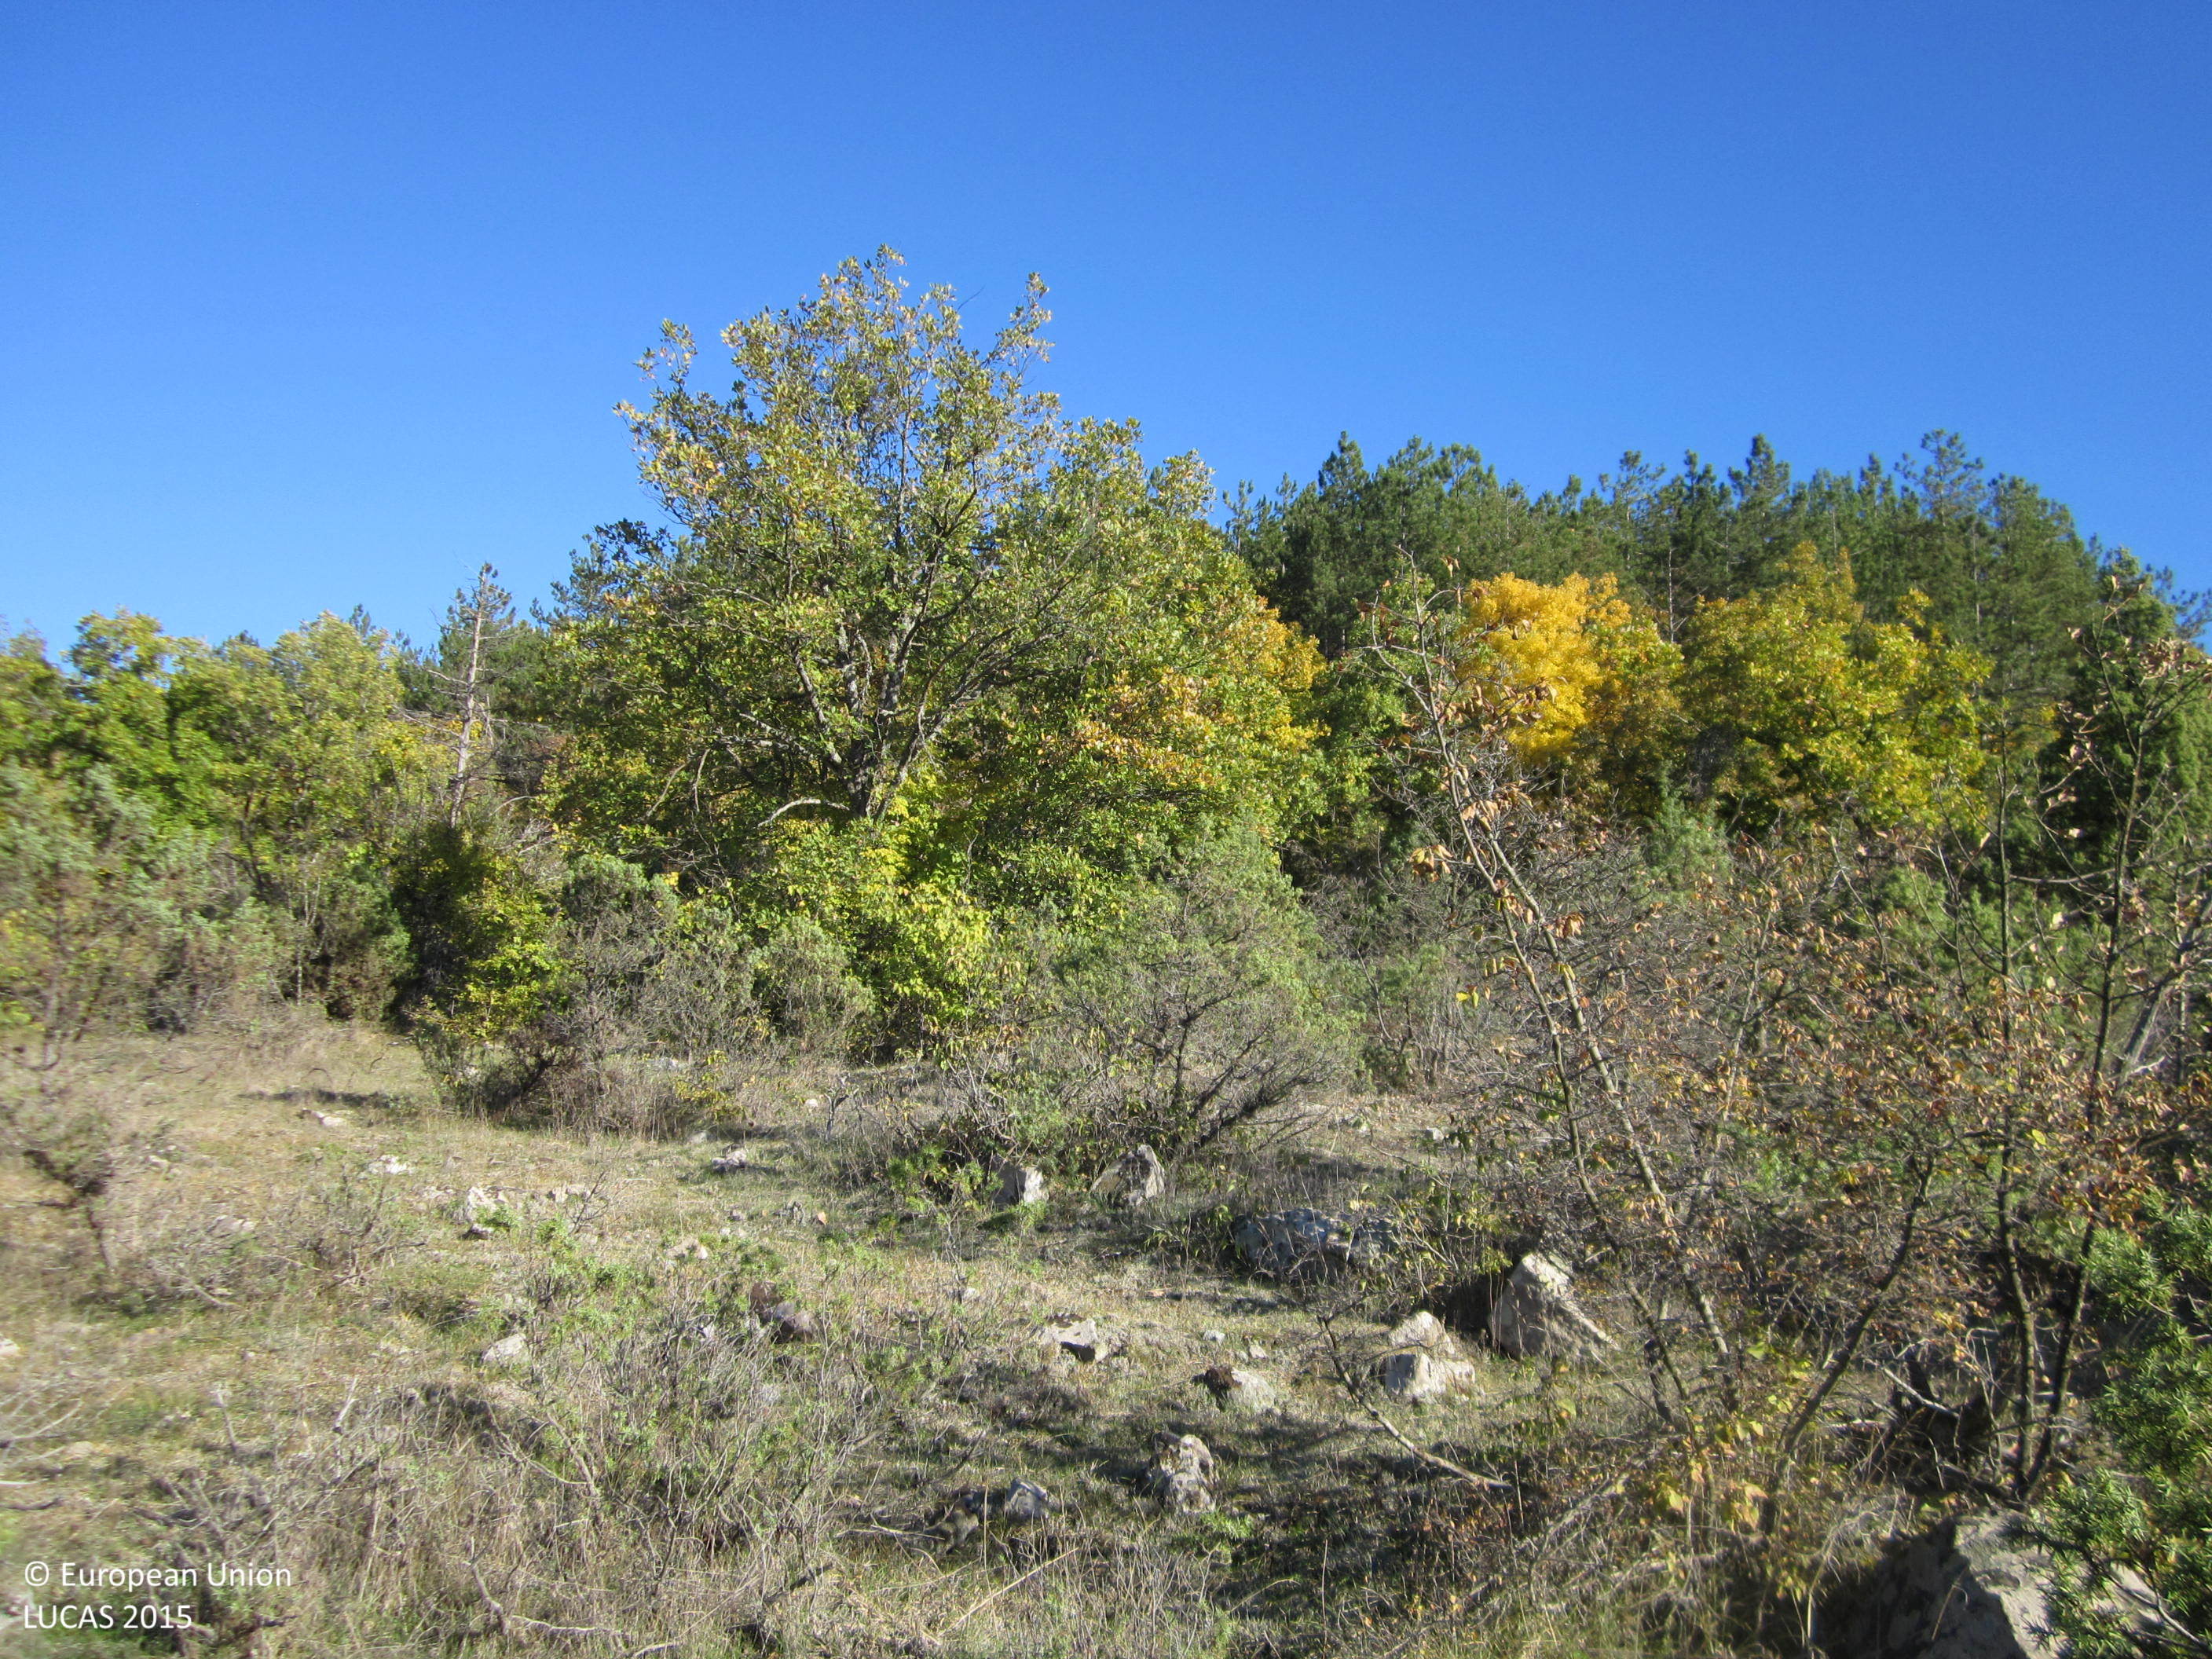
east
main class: Shrubland
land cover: Shrubland with sparse tree cover
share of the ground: 50 - 75 %
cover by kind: shrubs 55 %, herbaceous plants 35 %, broadleaved forest trees 5 %, unconsolidated bare surface 5 %
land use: Agriculture (excluding fallow land and kitchen gardens)
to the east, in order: Shrubland with sparse tree cover; Broadleaved woodland; Pine dominated coniferous woodland; Paved roads, cycling and walking lanes; Broadleaved woodland; Pine dominated coniferous woodland
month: November
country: BG
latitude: 41.6011
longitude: 25.7209
